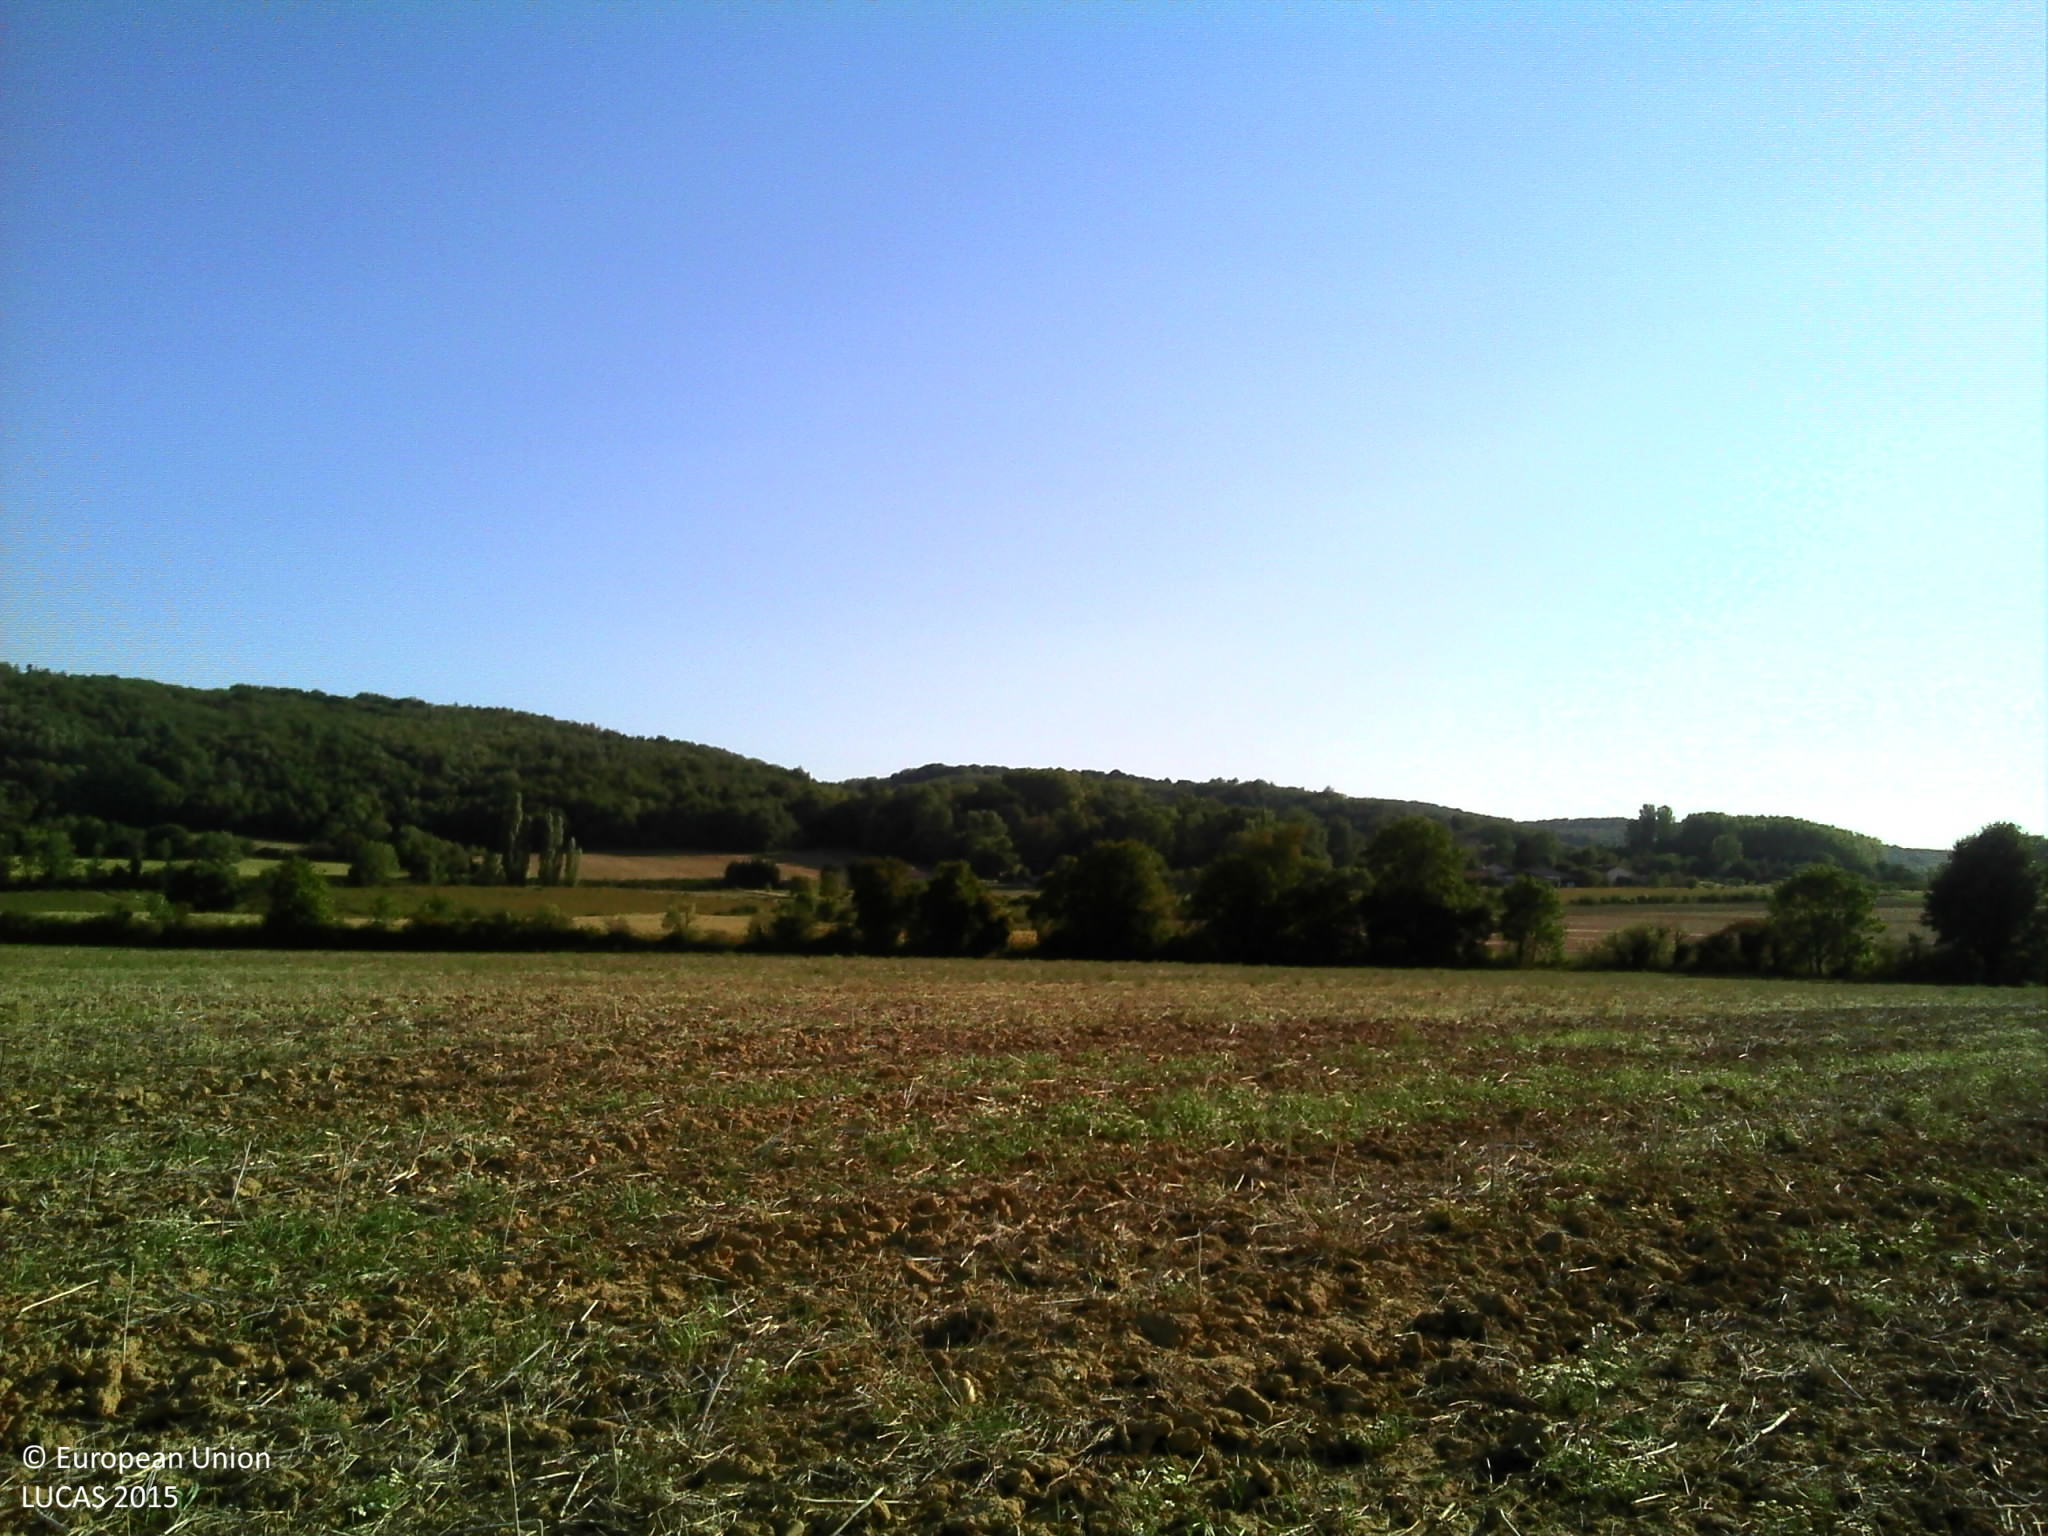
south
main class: Cropland
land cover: Rape and turnip rape
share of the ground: < 10 %
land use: Agriculture (excluding fallow land and kitchen gardens)
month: September
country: FR
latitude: 45.2966
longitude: 5.0189
